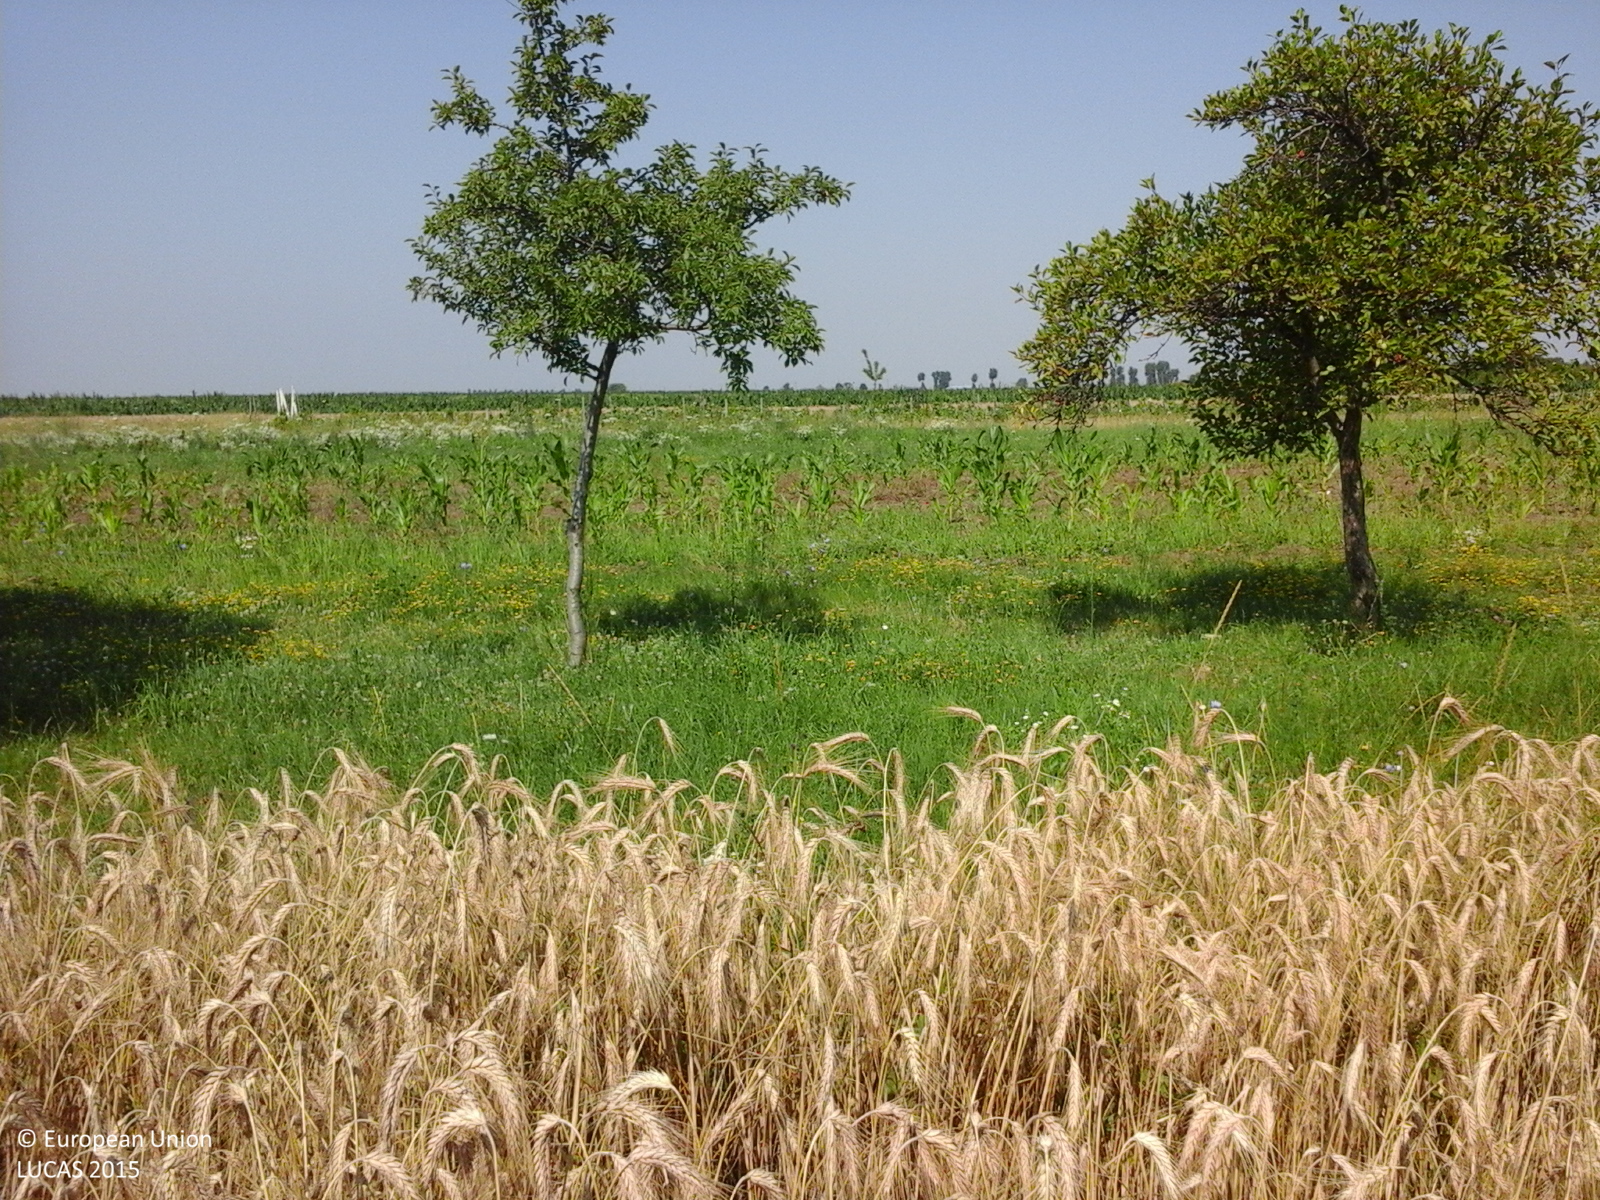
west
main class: Cropland
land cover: Common wheat
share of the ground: > 75 %
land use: Agriculture (excluding fallow land and kitchen gardens)
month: July
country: RO
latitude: 44.4904
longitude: 24.9305
